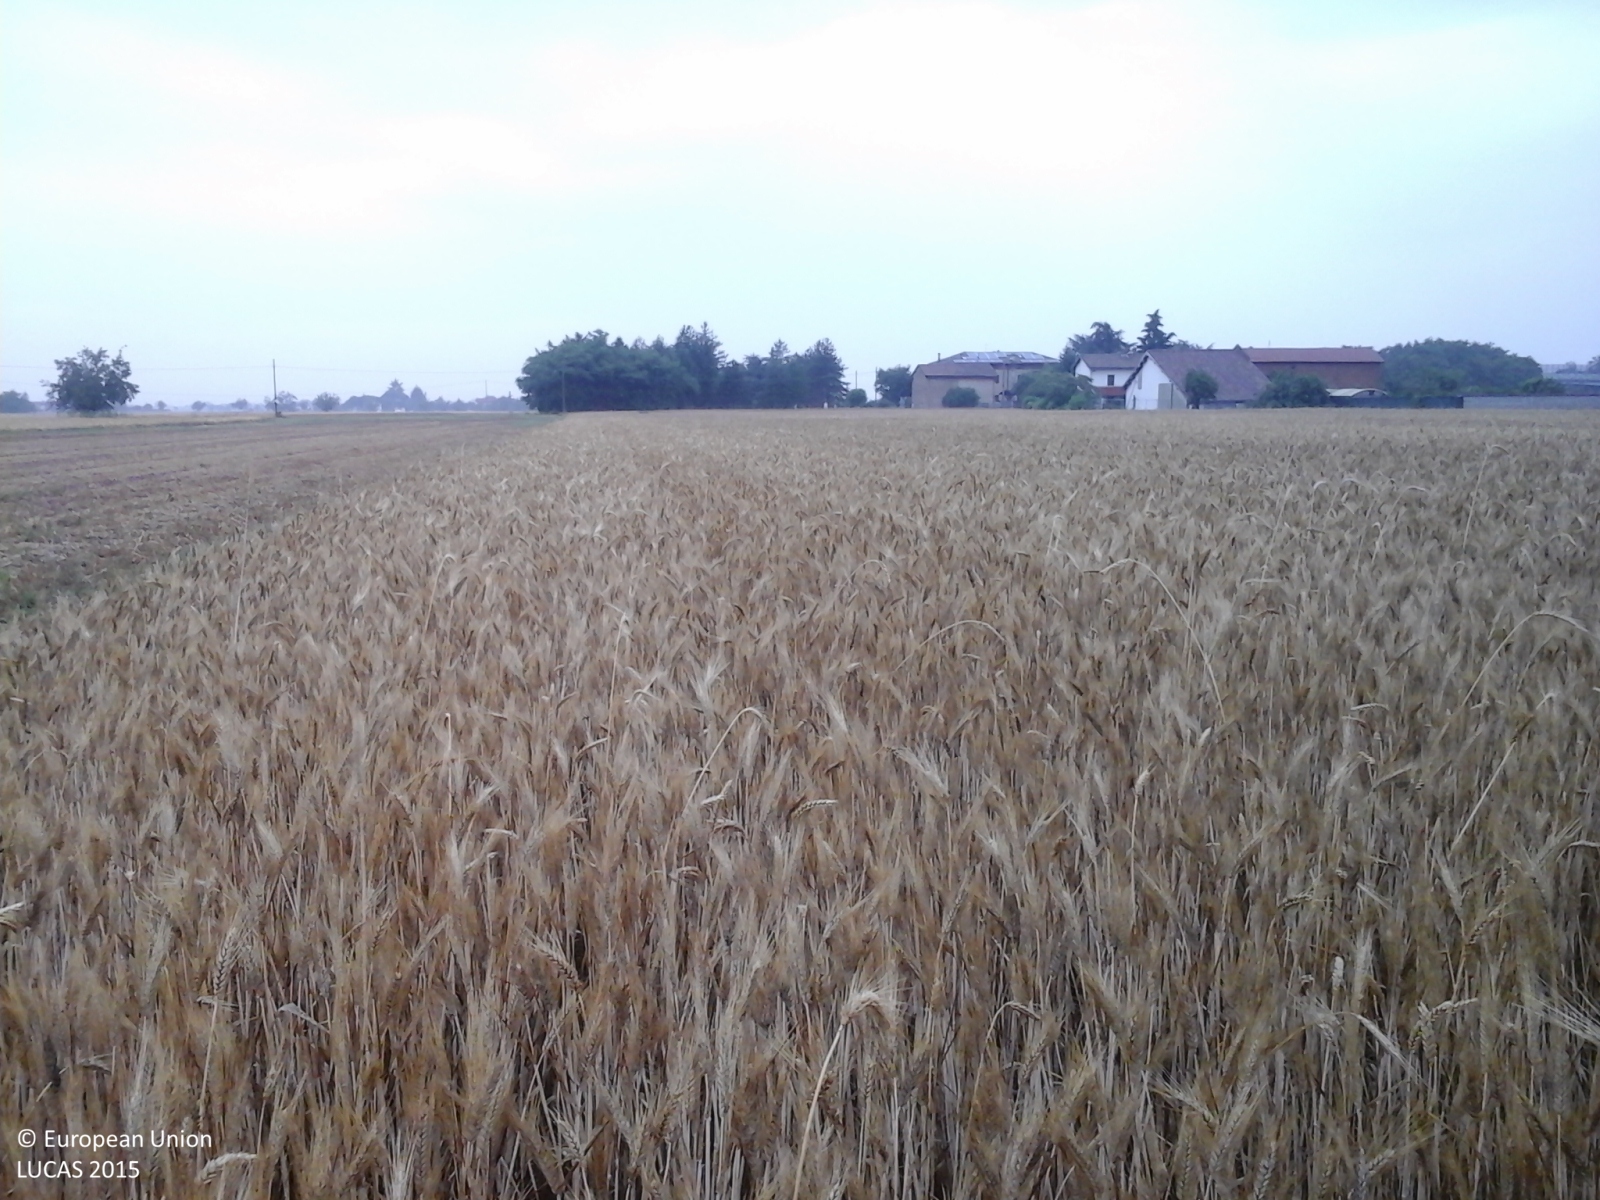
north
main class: Cropland
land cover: Common wheat
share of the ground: > 75 %
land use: Agriculture (excluding fallow land and kitchen gardens)
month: June
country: IT
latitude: 44.8128
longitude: 8.8264
